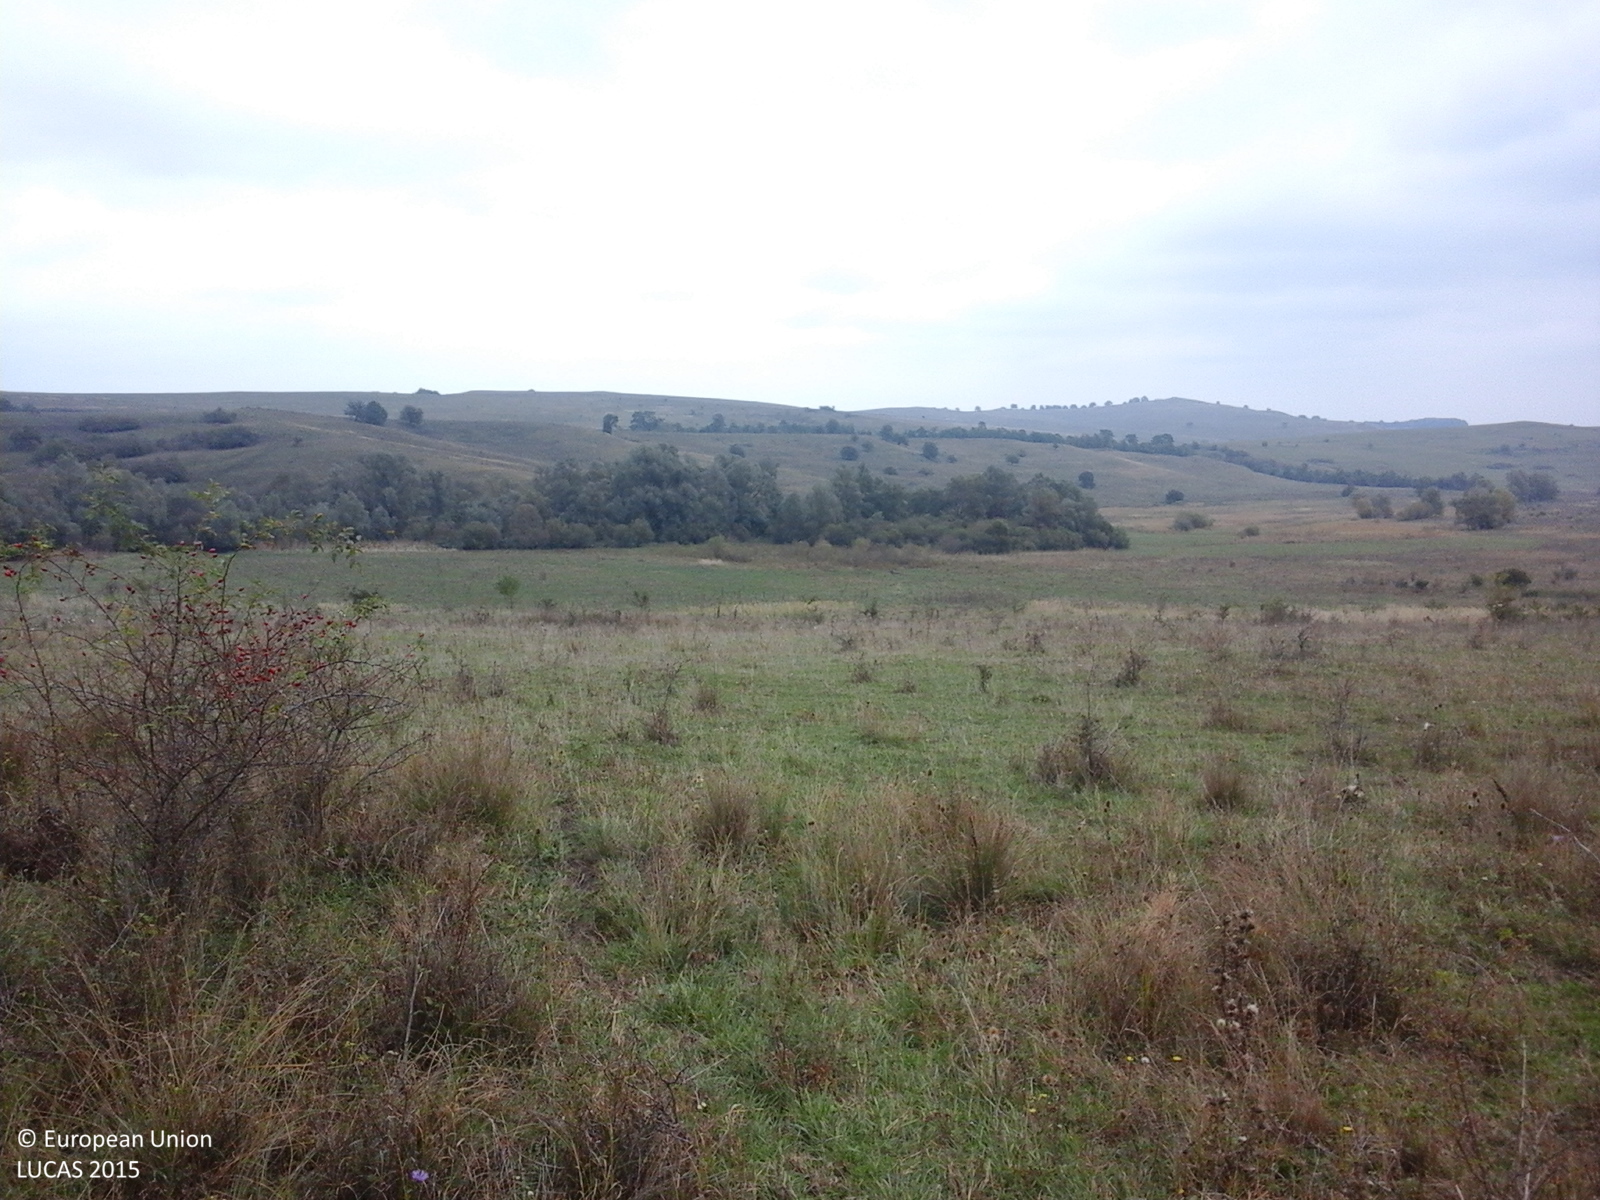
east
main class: Grassland
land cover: Grassland with sparse tree/shrub cover
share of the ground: > 75 %
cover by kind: herbaceous plants 85 %, shrubs 10 %, broadleaved forest trees 5 %
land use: Fallow land
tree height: < 5 m
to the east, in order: Grassland with sparse tree/shrub cover
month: October
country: RO
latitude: 46.0547
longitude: 25.1289
